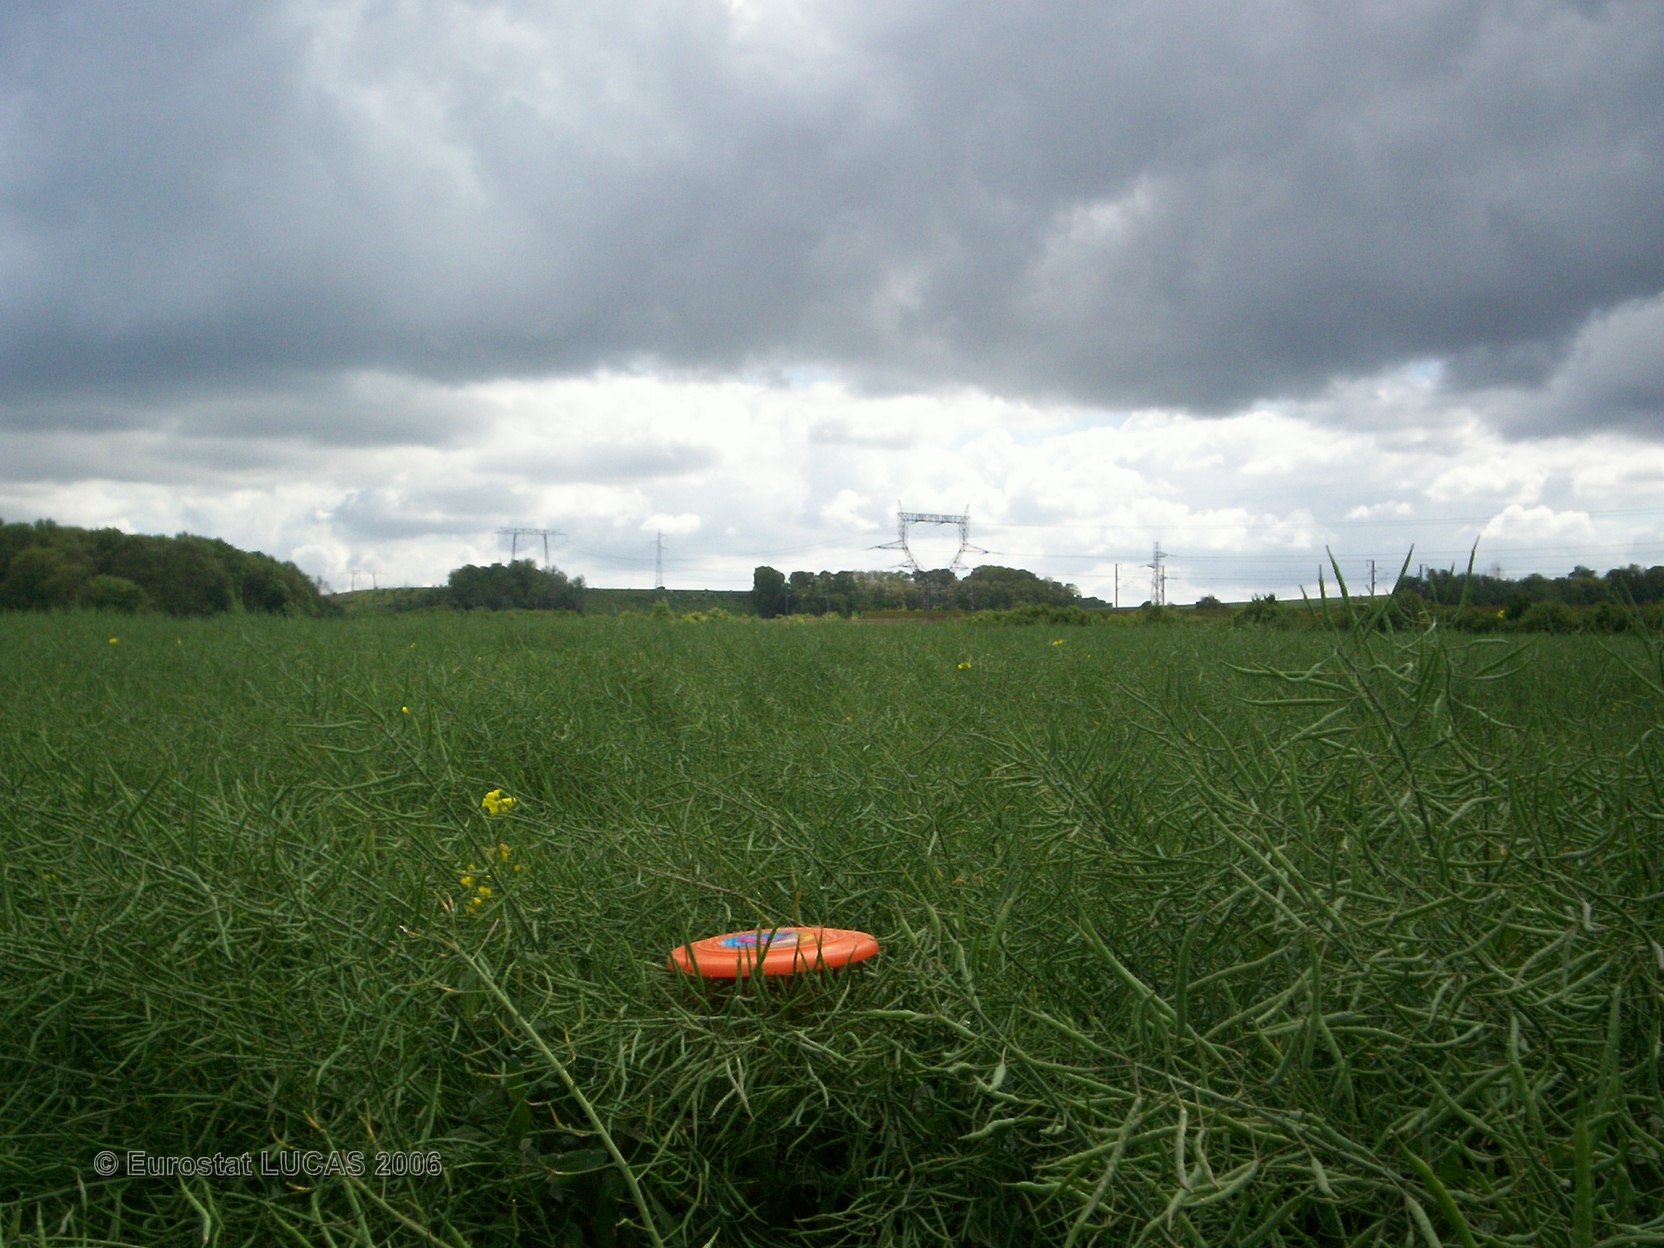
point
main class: Cropland
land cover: Rape and turnip rape
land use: Agriculture (excluding fallow land and kitchen gardens)
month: May
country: FR
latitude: 49.2133
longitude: 2.7551
